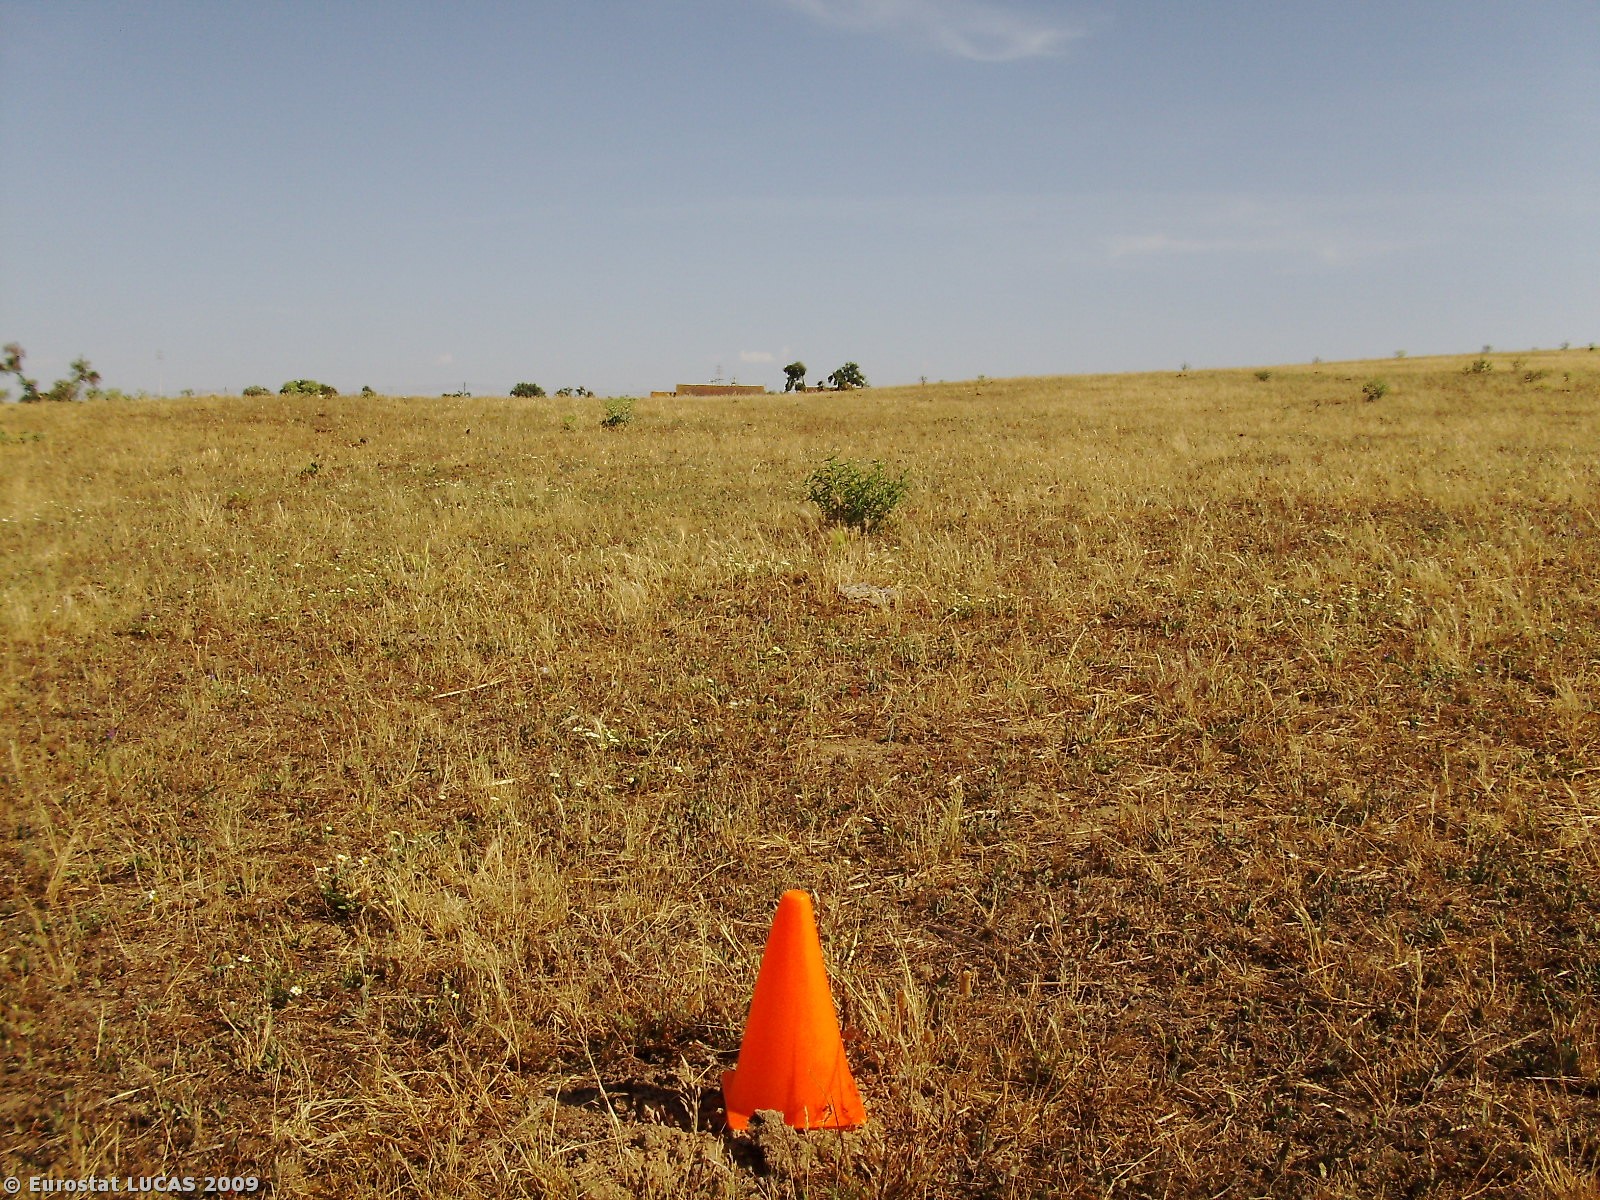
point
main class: Grassland
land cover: Grassland without tree/shrub cover
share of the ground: > 75 %
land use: Agriculture (excluding fallow land and kitchen gardens)
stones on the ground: 10 - 25 %
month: June
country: PT
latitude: 39.0667
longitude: -7.4079
